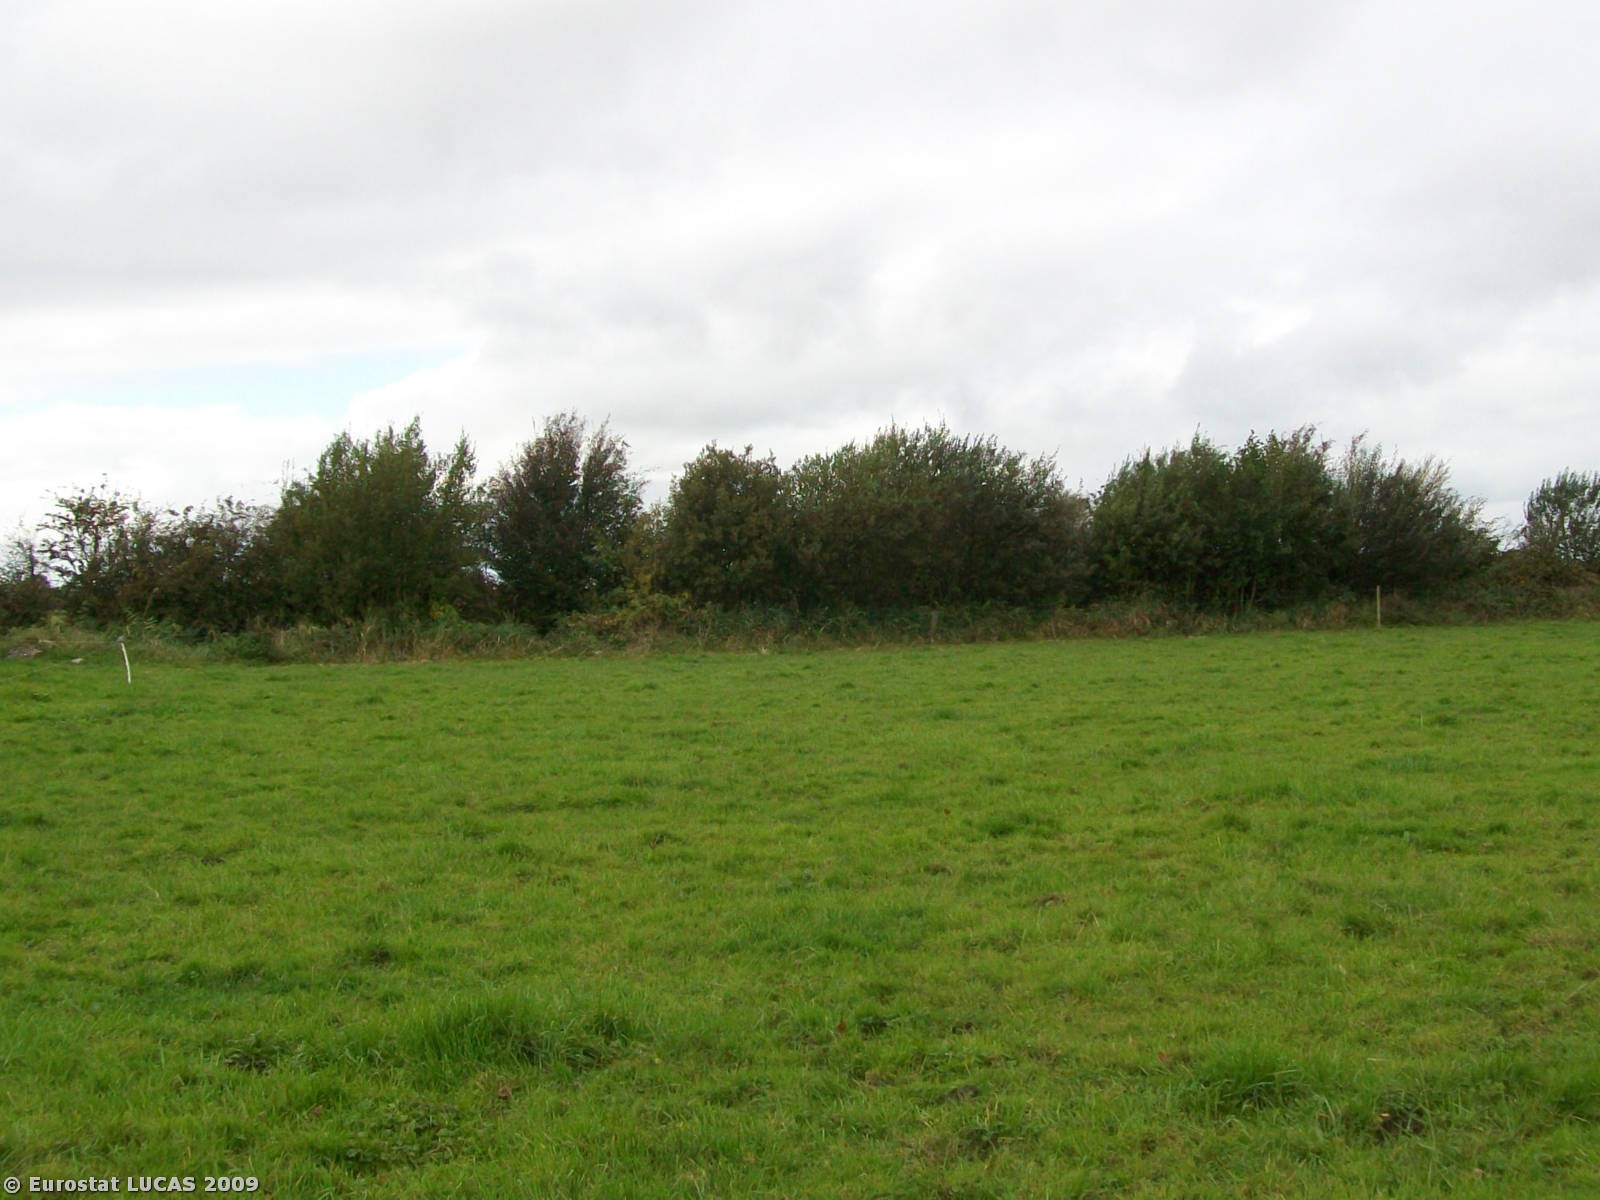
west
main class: Grassland
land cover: Grassland without tree/shrub cover
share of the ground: > 75 %
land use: Agriculture (excluding fallow land and kitchen gardens)
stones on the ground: < 10 %
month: September
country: IE
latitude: 53.2027
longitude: -7.9750
